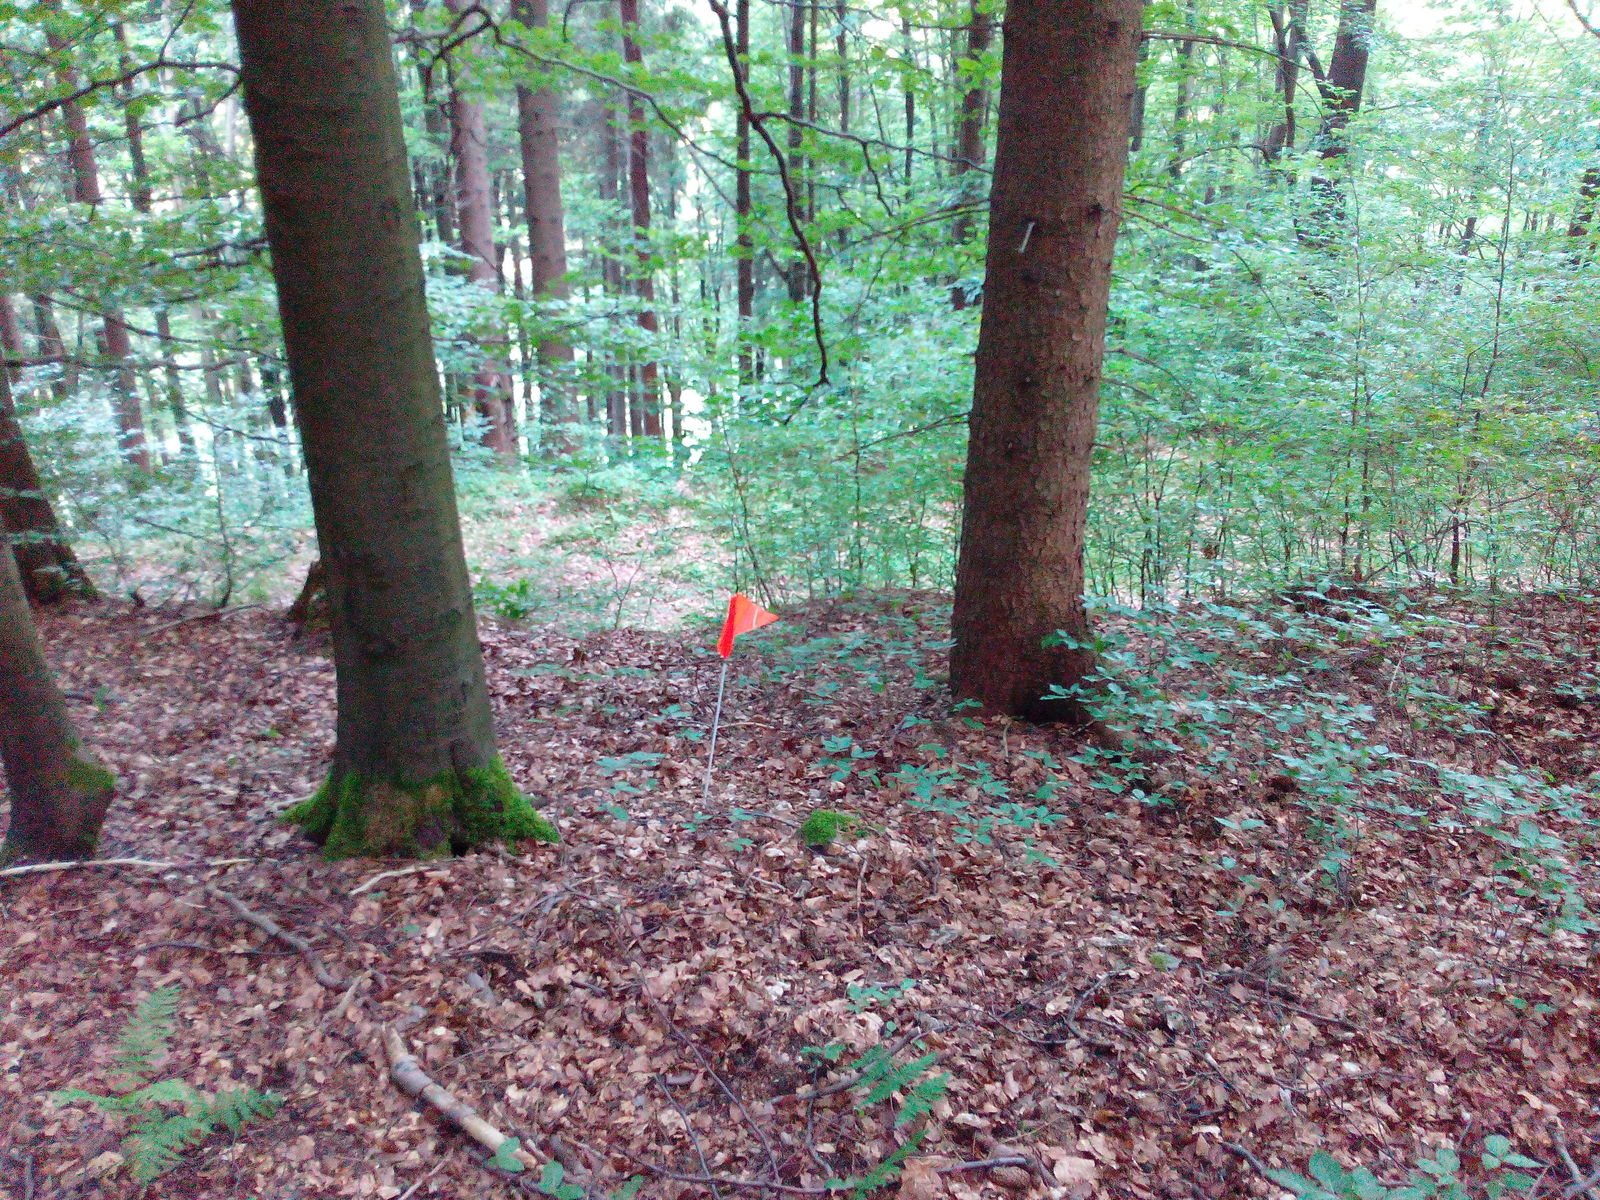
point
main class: Woodland
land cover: Spruce dominated mixed woodland
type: hemiboreal forest and nemoral coniferous forest and mixed broadleaved-coniferous forest
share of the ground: > 75 %
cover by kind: coniferous forest trees 50 %, broadleaved forest trees 50 %
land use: Forestry
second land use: Amenities, museums, leisure
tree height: > 5 m
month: July
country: DE
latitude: 50.6307
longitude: 10.8339
